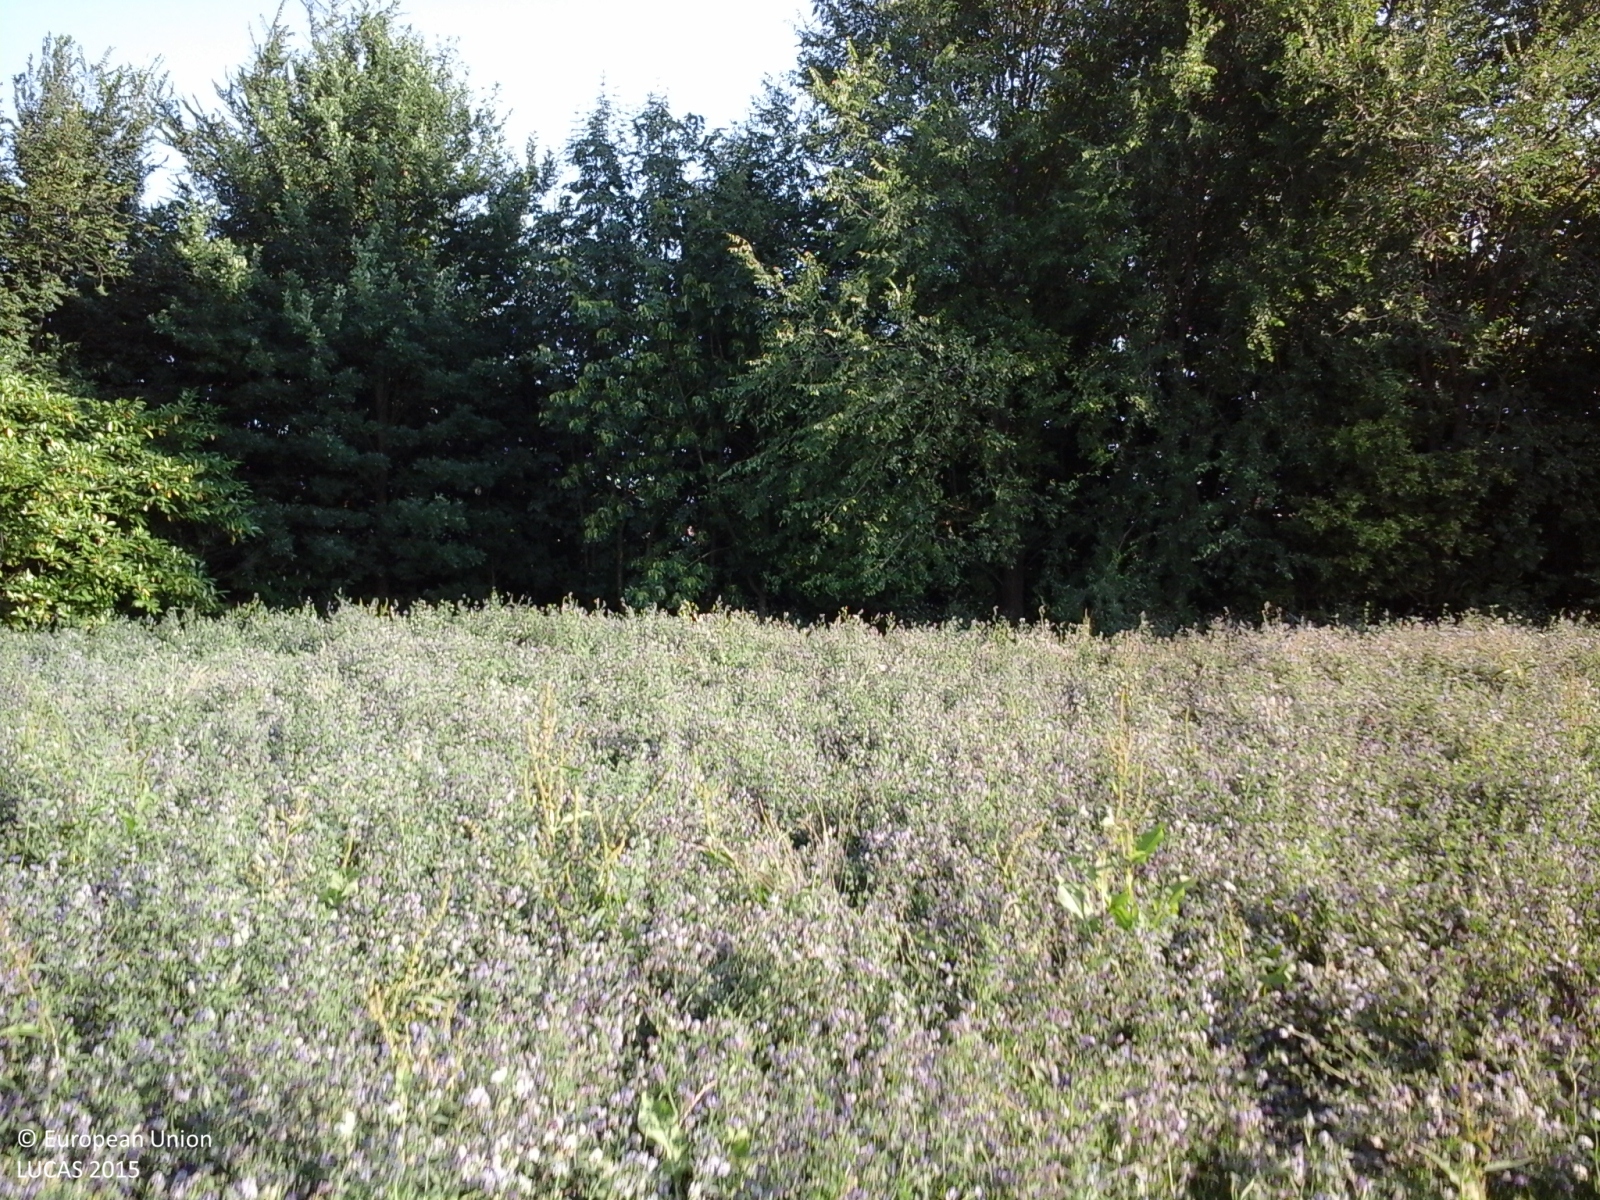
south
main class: Cropland
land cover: Lucerne
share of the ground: > 75 %
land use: Agriculture (excluding fallow land and kitchen gardens)
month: July
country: IT
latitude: 44.6471
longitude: 11.4470
